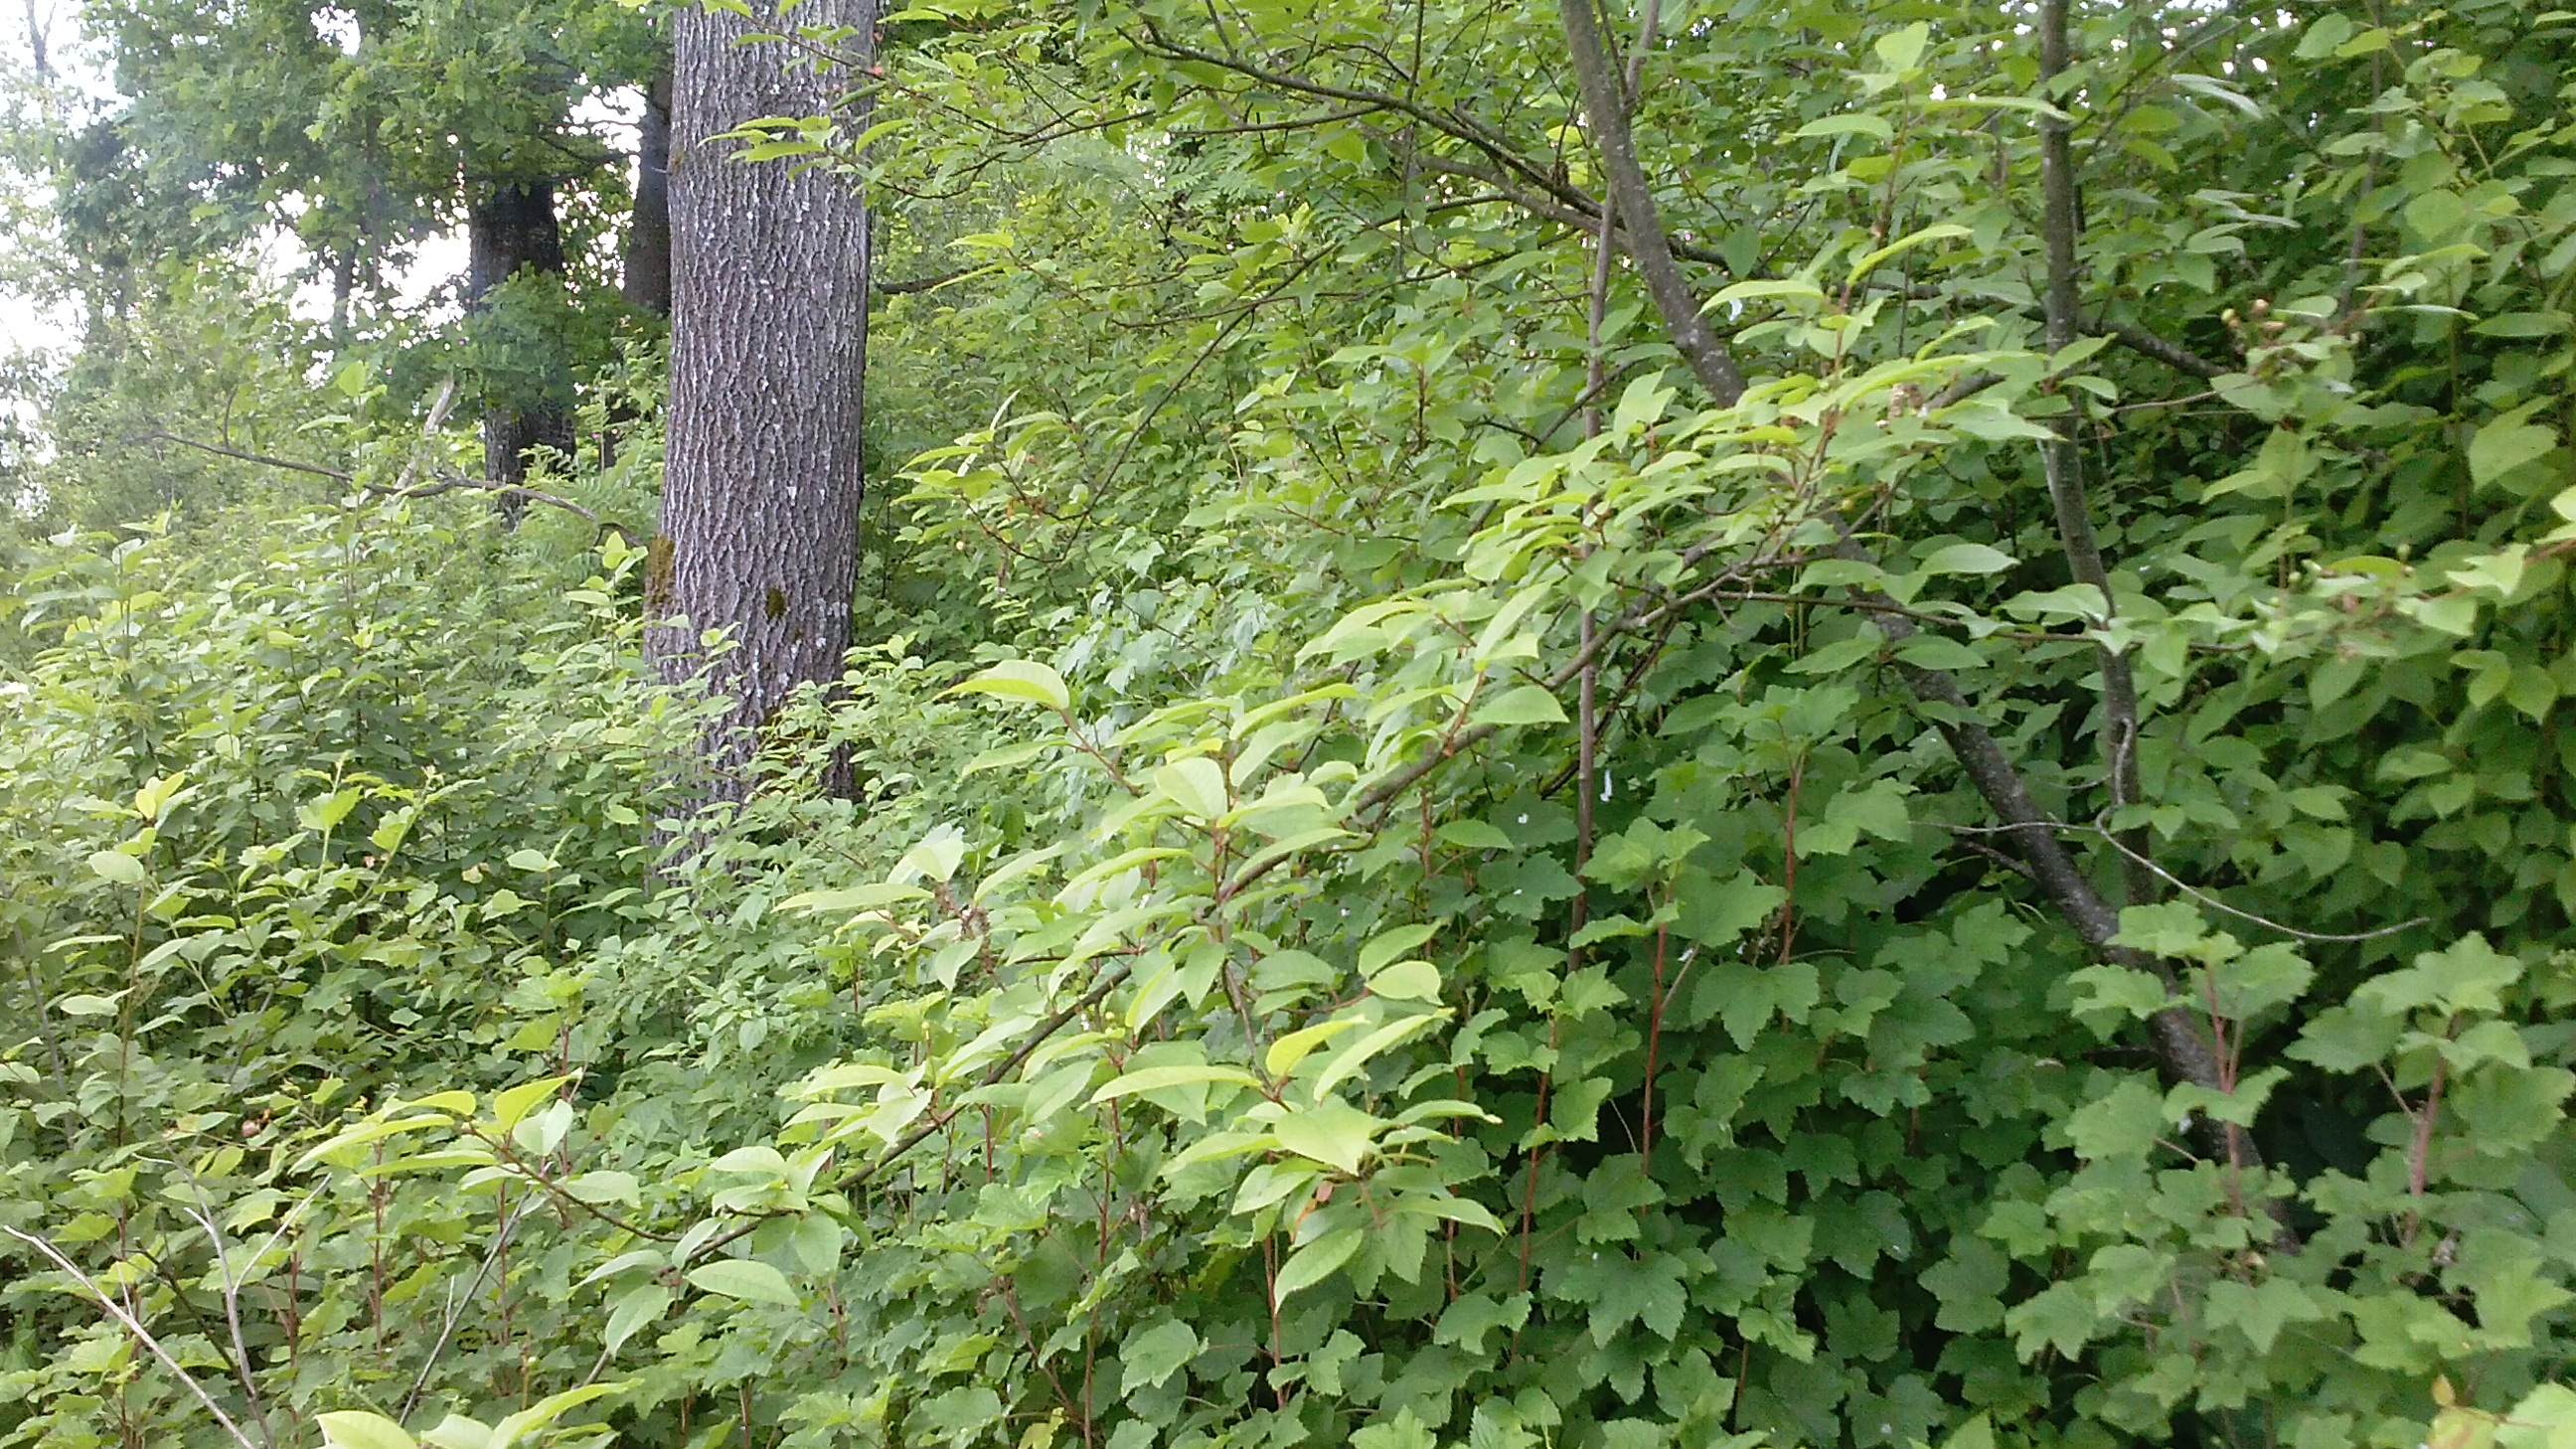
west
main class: Woodland
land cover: Broadleaved woodland
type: non-riverine alder, birch or aspen forest
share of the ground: 50 - 75 %
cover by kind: broadleaved forest trees 65 %, herbaceous plants 30 %, shrubs 5 %
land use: Forestry
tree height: < 5 m
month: June
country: LV
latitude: 56.3210
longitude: 28.1337
